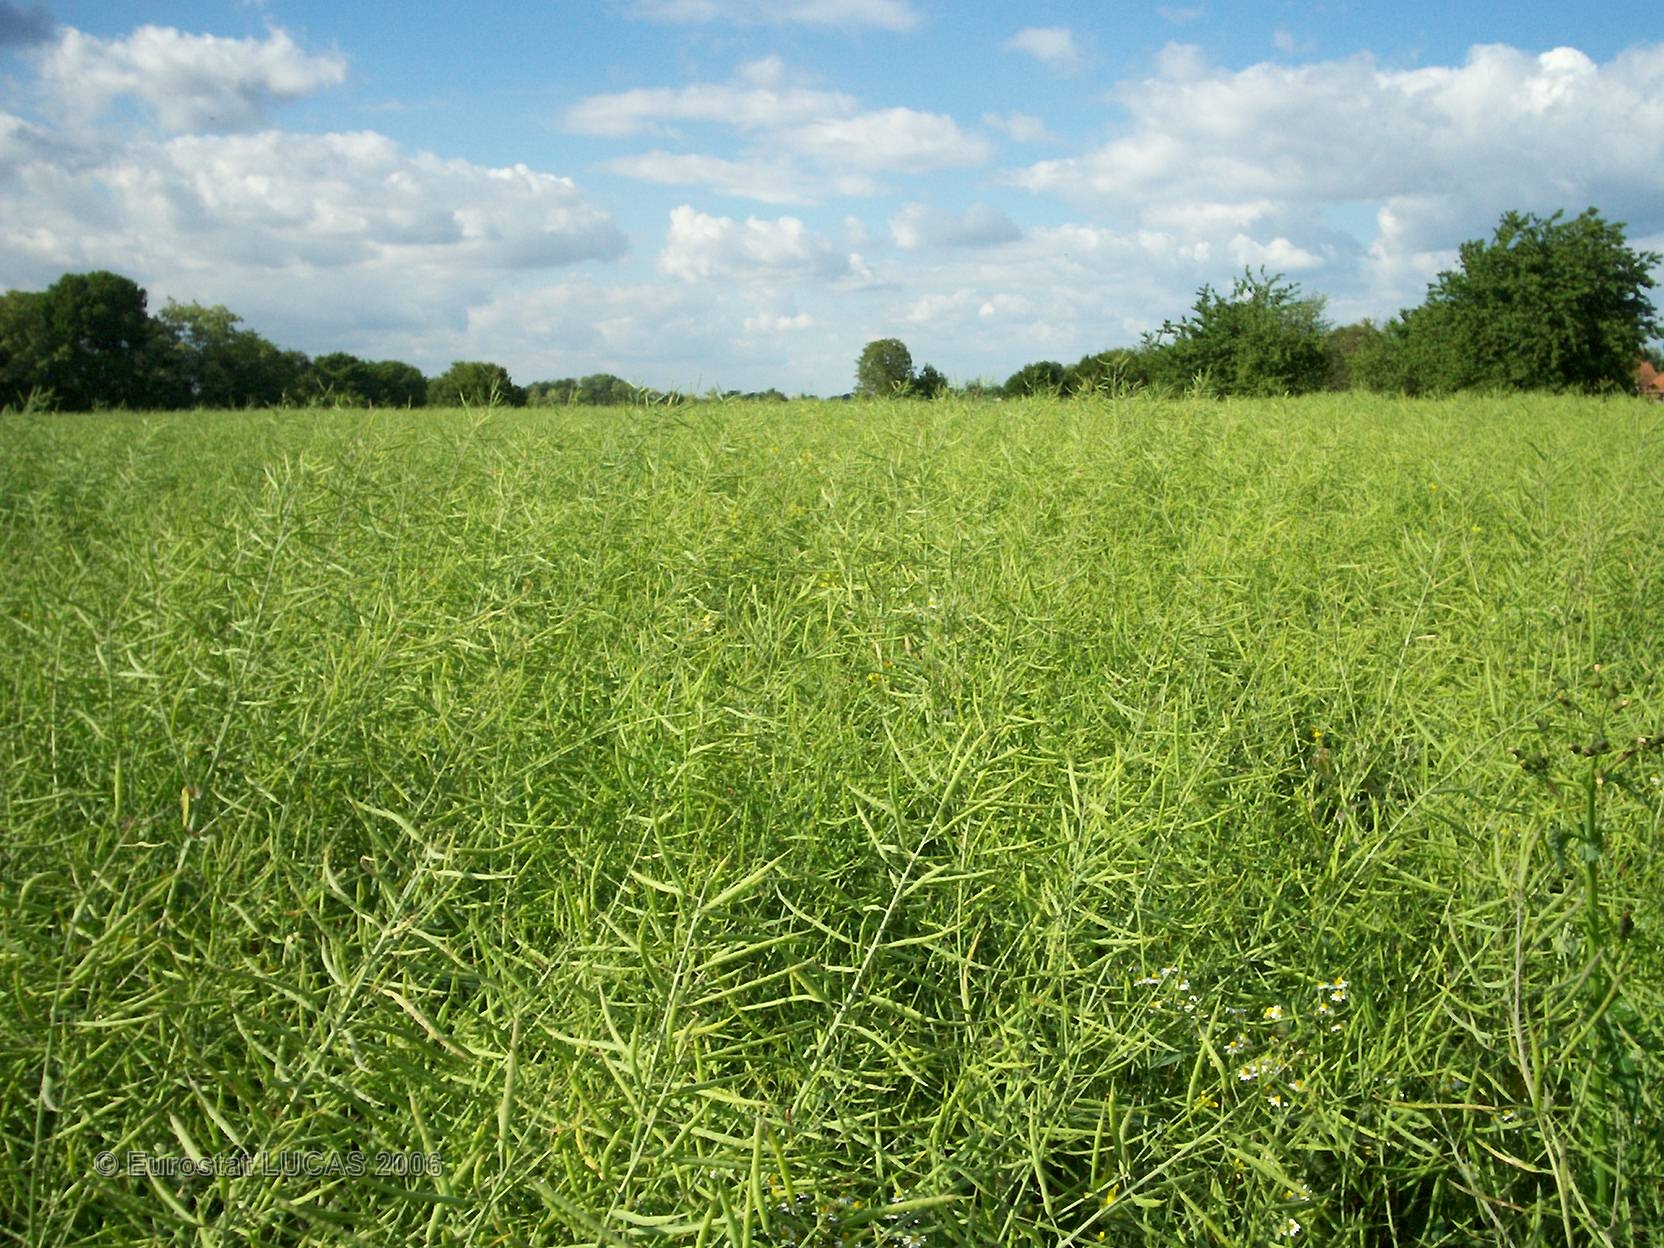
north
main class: Cropland
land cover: Rape and turnip rape
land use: Agriculture (excluding fallow land and kitchen gardens)
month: June
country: FR
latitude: 47.1156
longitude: 2.9970
